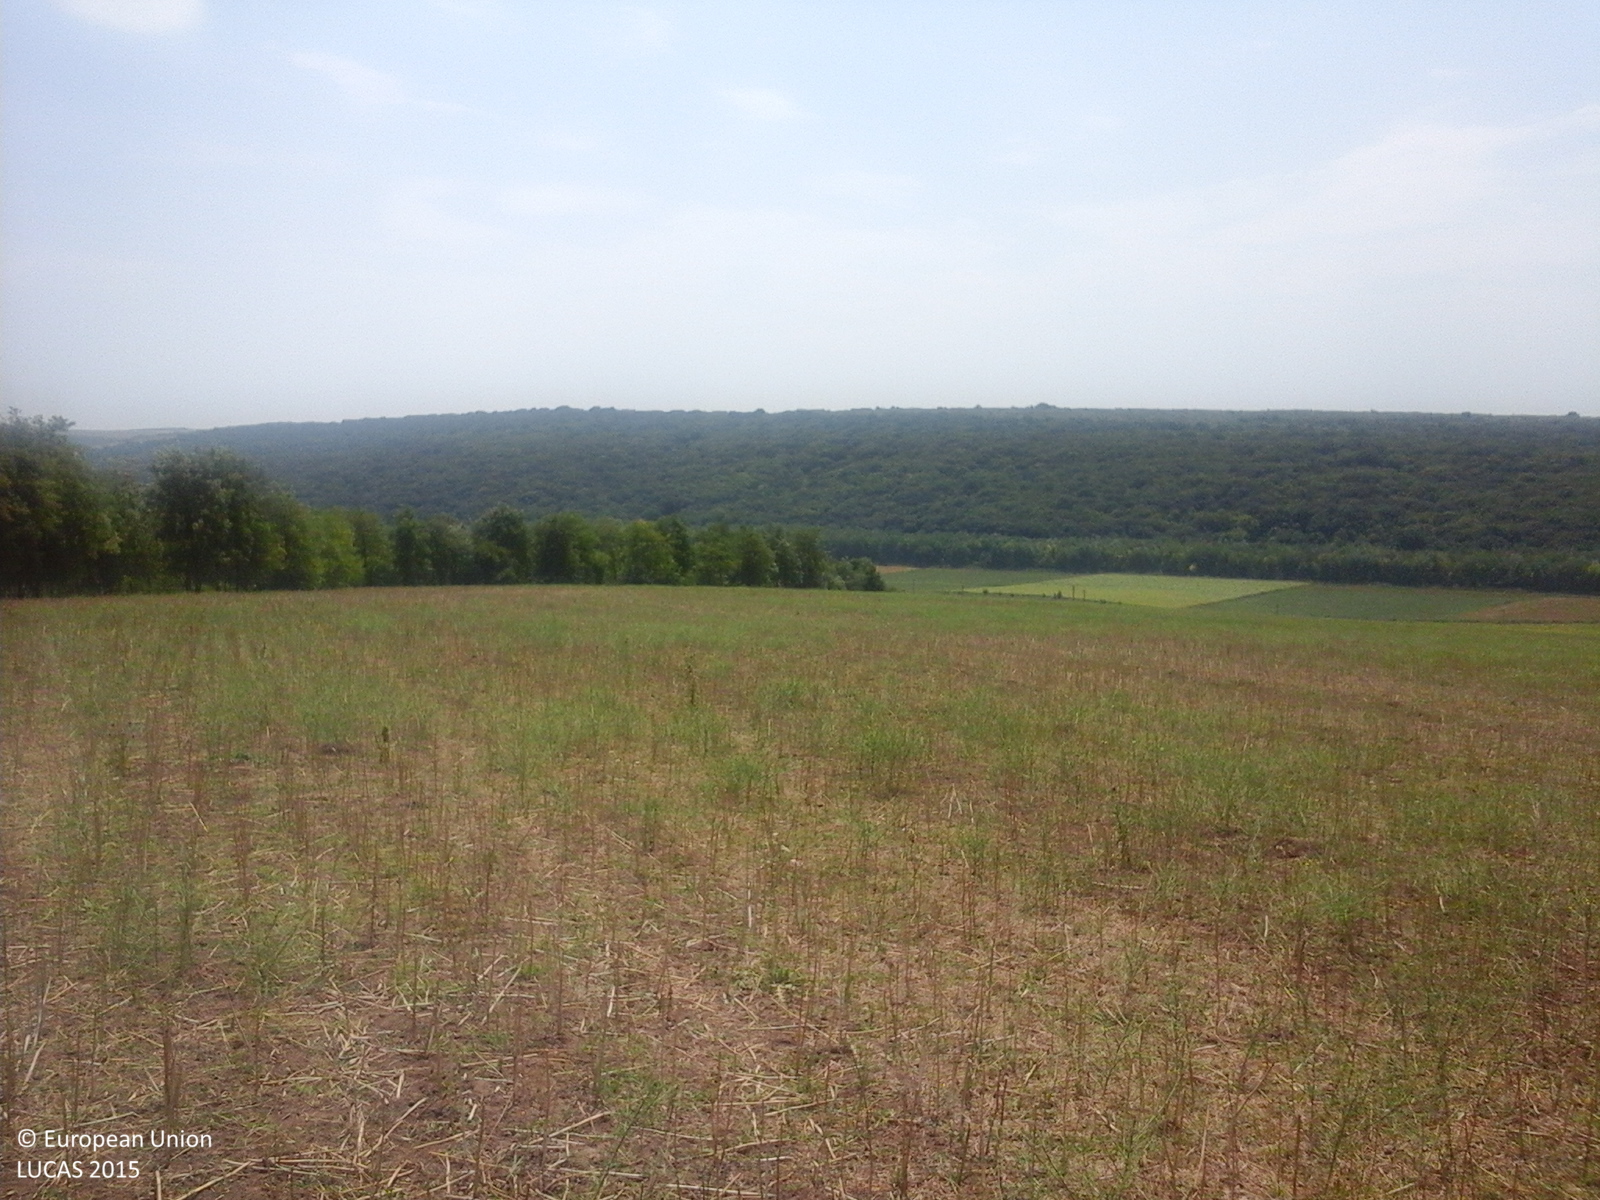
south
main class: Cropland
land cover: Rape and turnip rape
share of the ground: 25 - 50 %
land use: Agriculture (excluding fallow land and kitchen gardens)
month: August
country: RO
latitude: 44.0401
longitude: 27.8561
